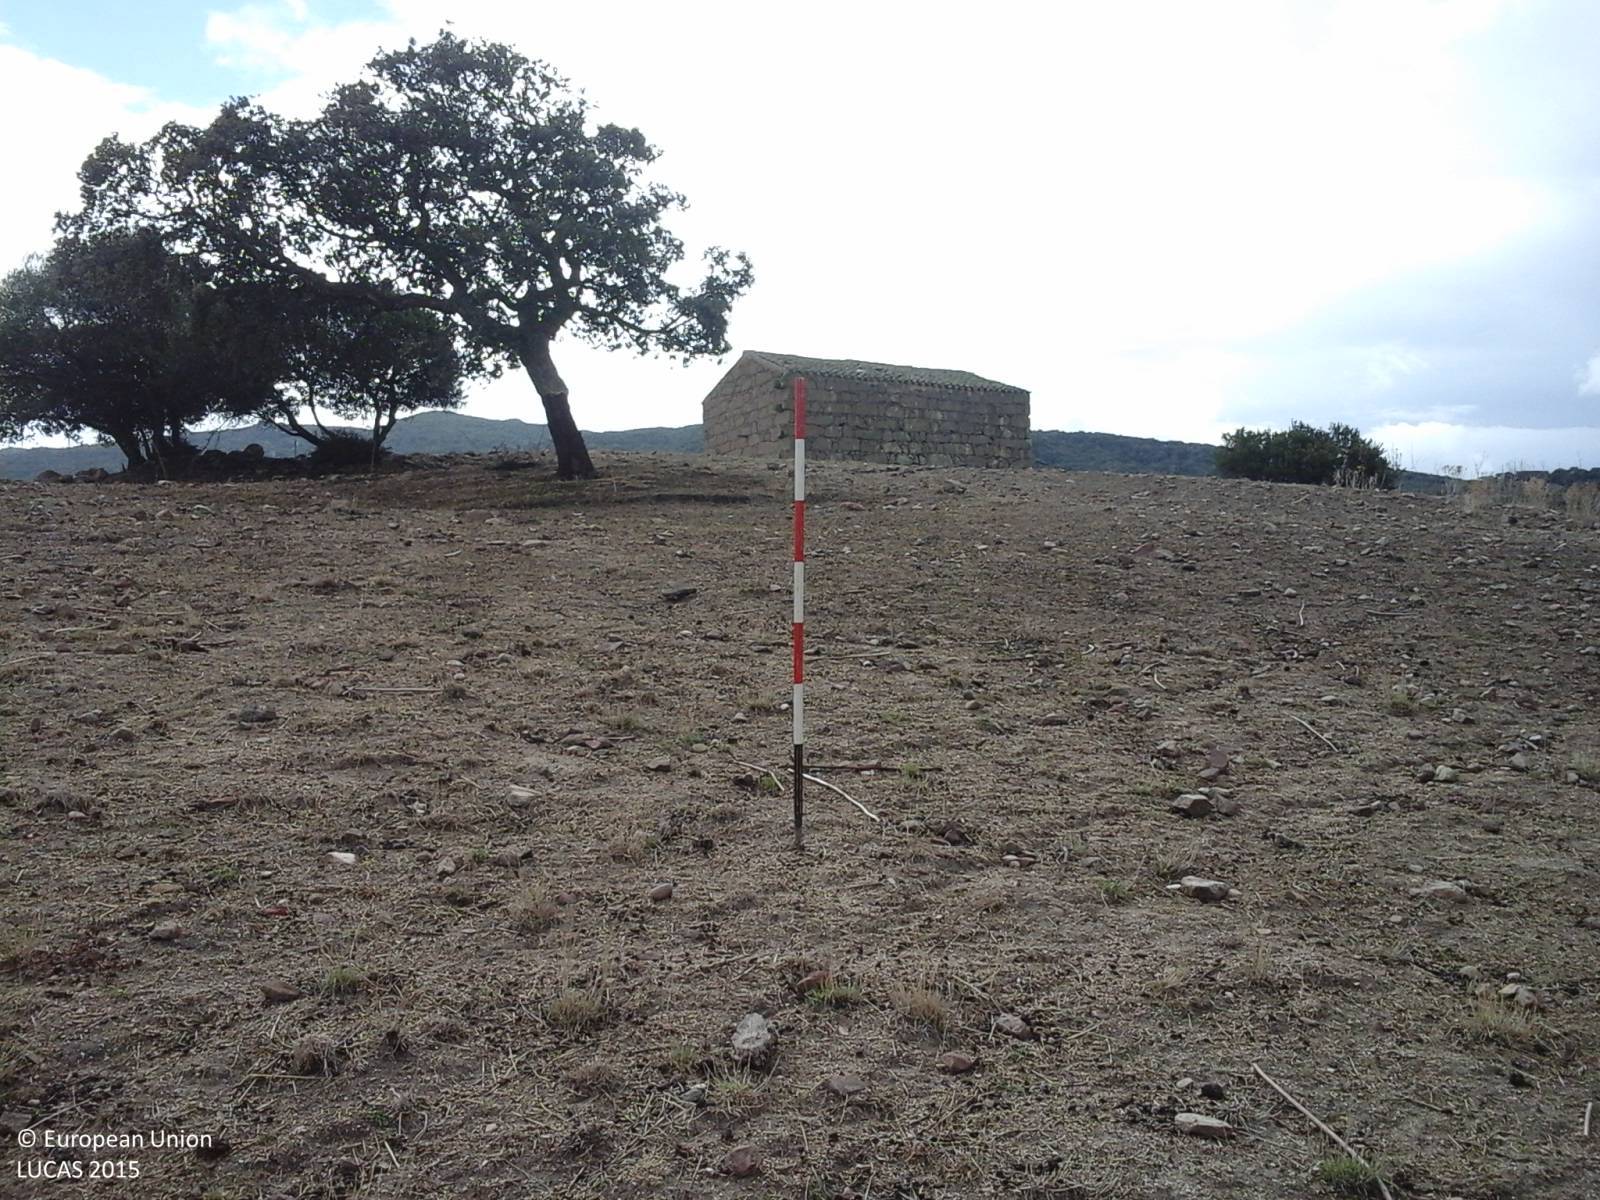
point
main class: Grassland
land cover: Grassland with sparse tree/shrub cover
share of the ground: > 75 %
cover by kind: herbaceous plants 95 %, broadleaved forest trees 5 %
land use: Agriculture (excluding fallow land and kitchen gardens)
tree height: < 5 m
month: October
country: IT
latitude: 40.1354
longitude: 8.9844
